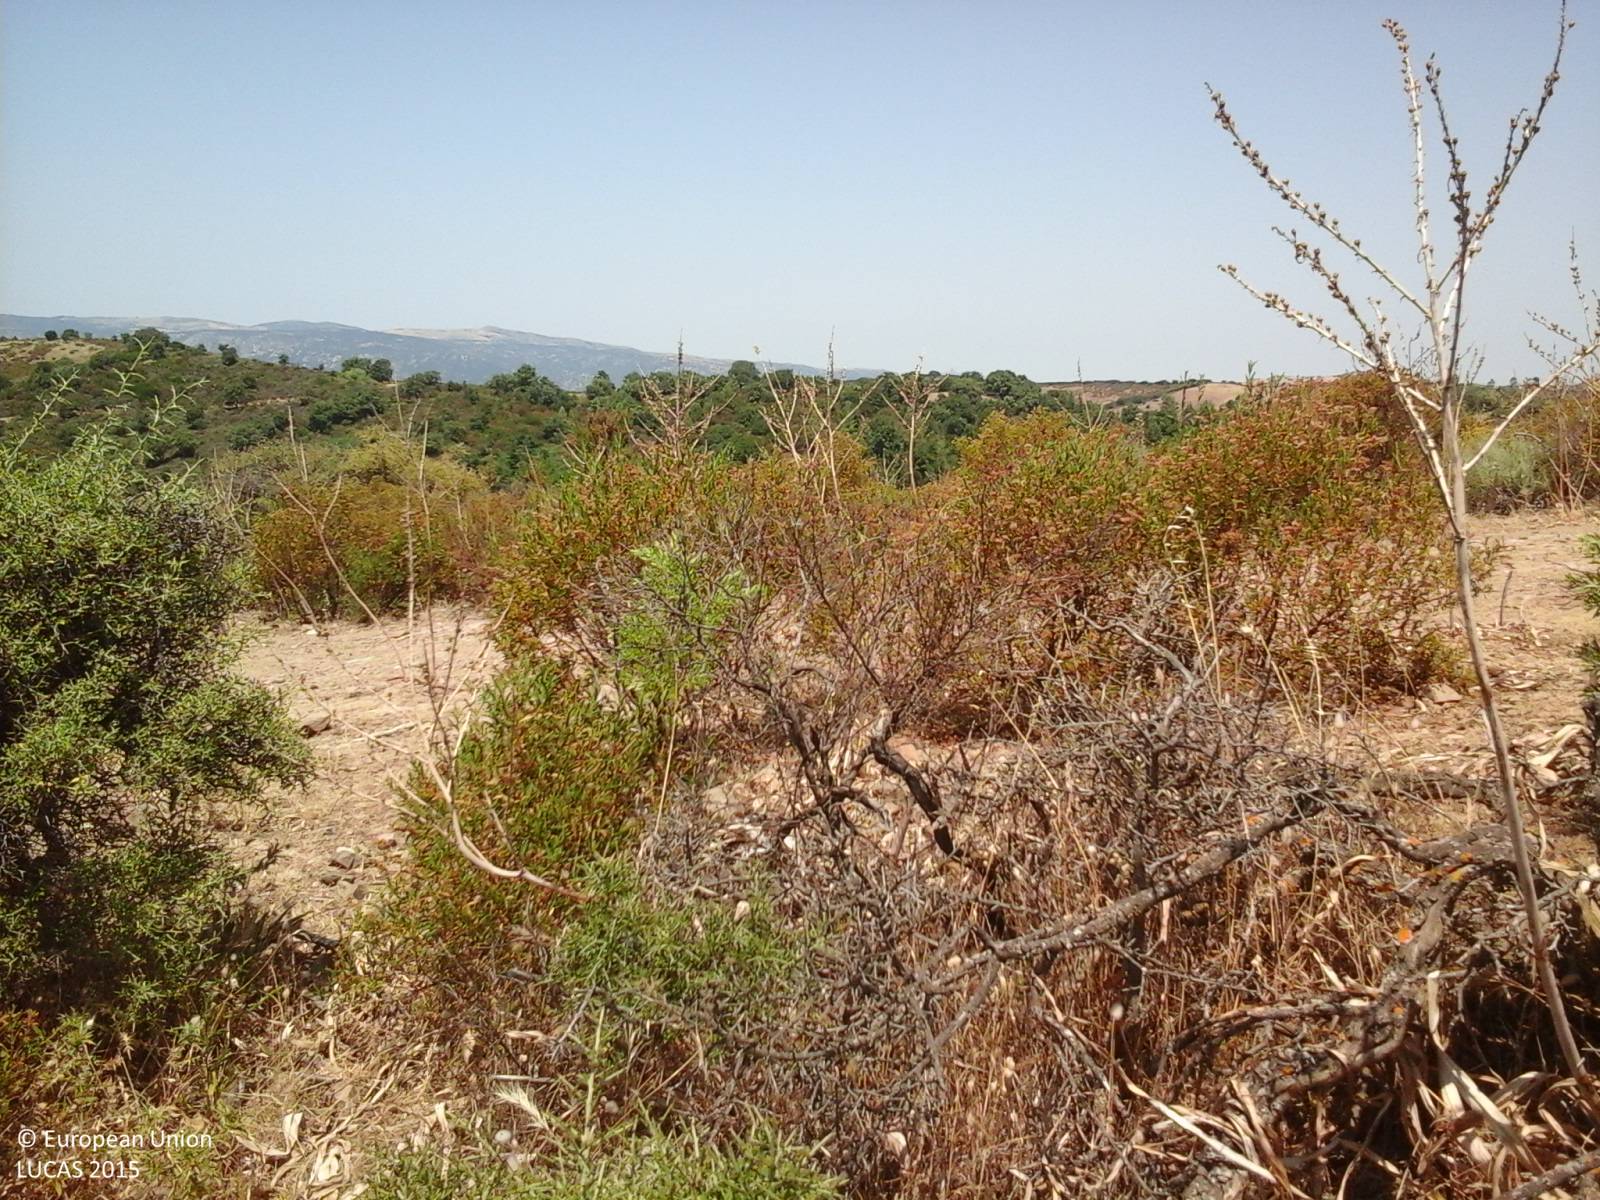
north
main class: Shrubland
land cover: Shrubland without tree cover
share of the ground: > 75 %
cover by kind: shrubs 95 %, herbaceous plants 5 %
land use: Semi-natural and natural areas not in use
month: July
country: IT
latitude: 40.4834
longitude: 9.5188
